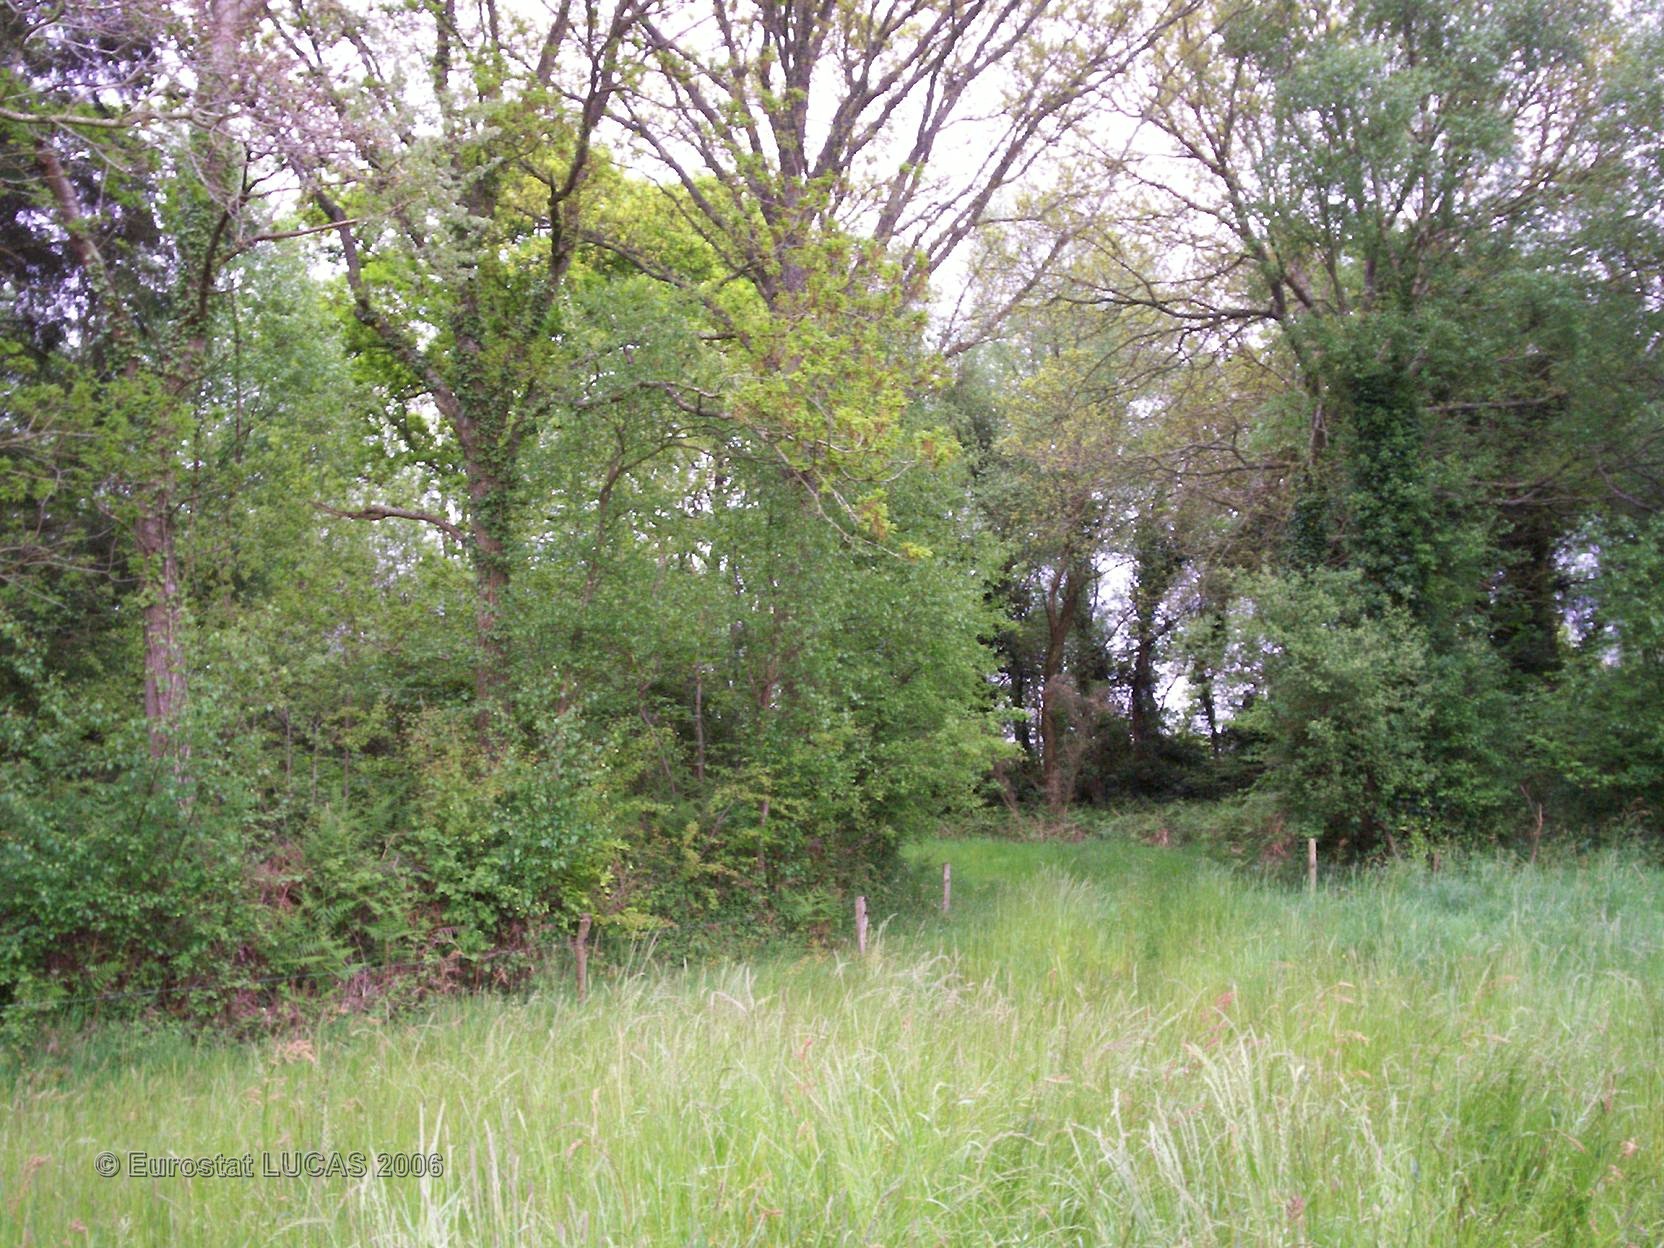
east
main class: Grassland
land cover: Grassland without tree/shrub cover
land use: Agriculture (excluding fallow land and kitchen gardens)
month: May
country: FR
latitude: 48.6630
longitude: -3.8123
